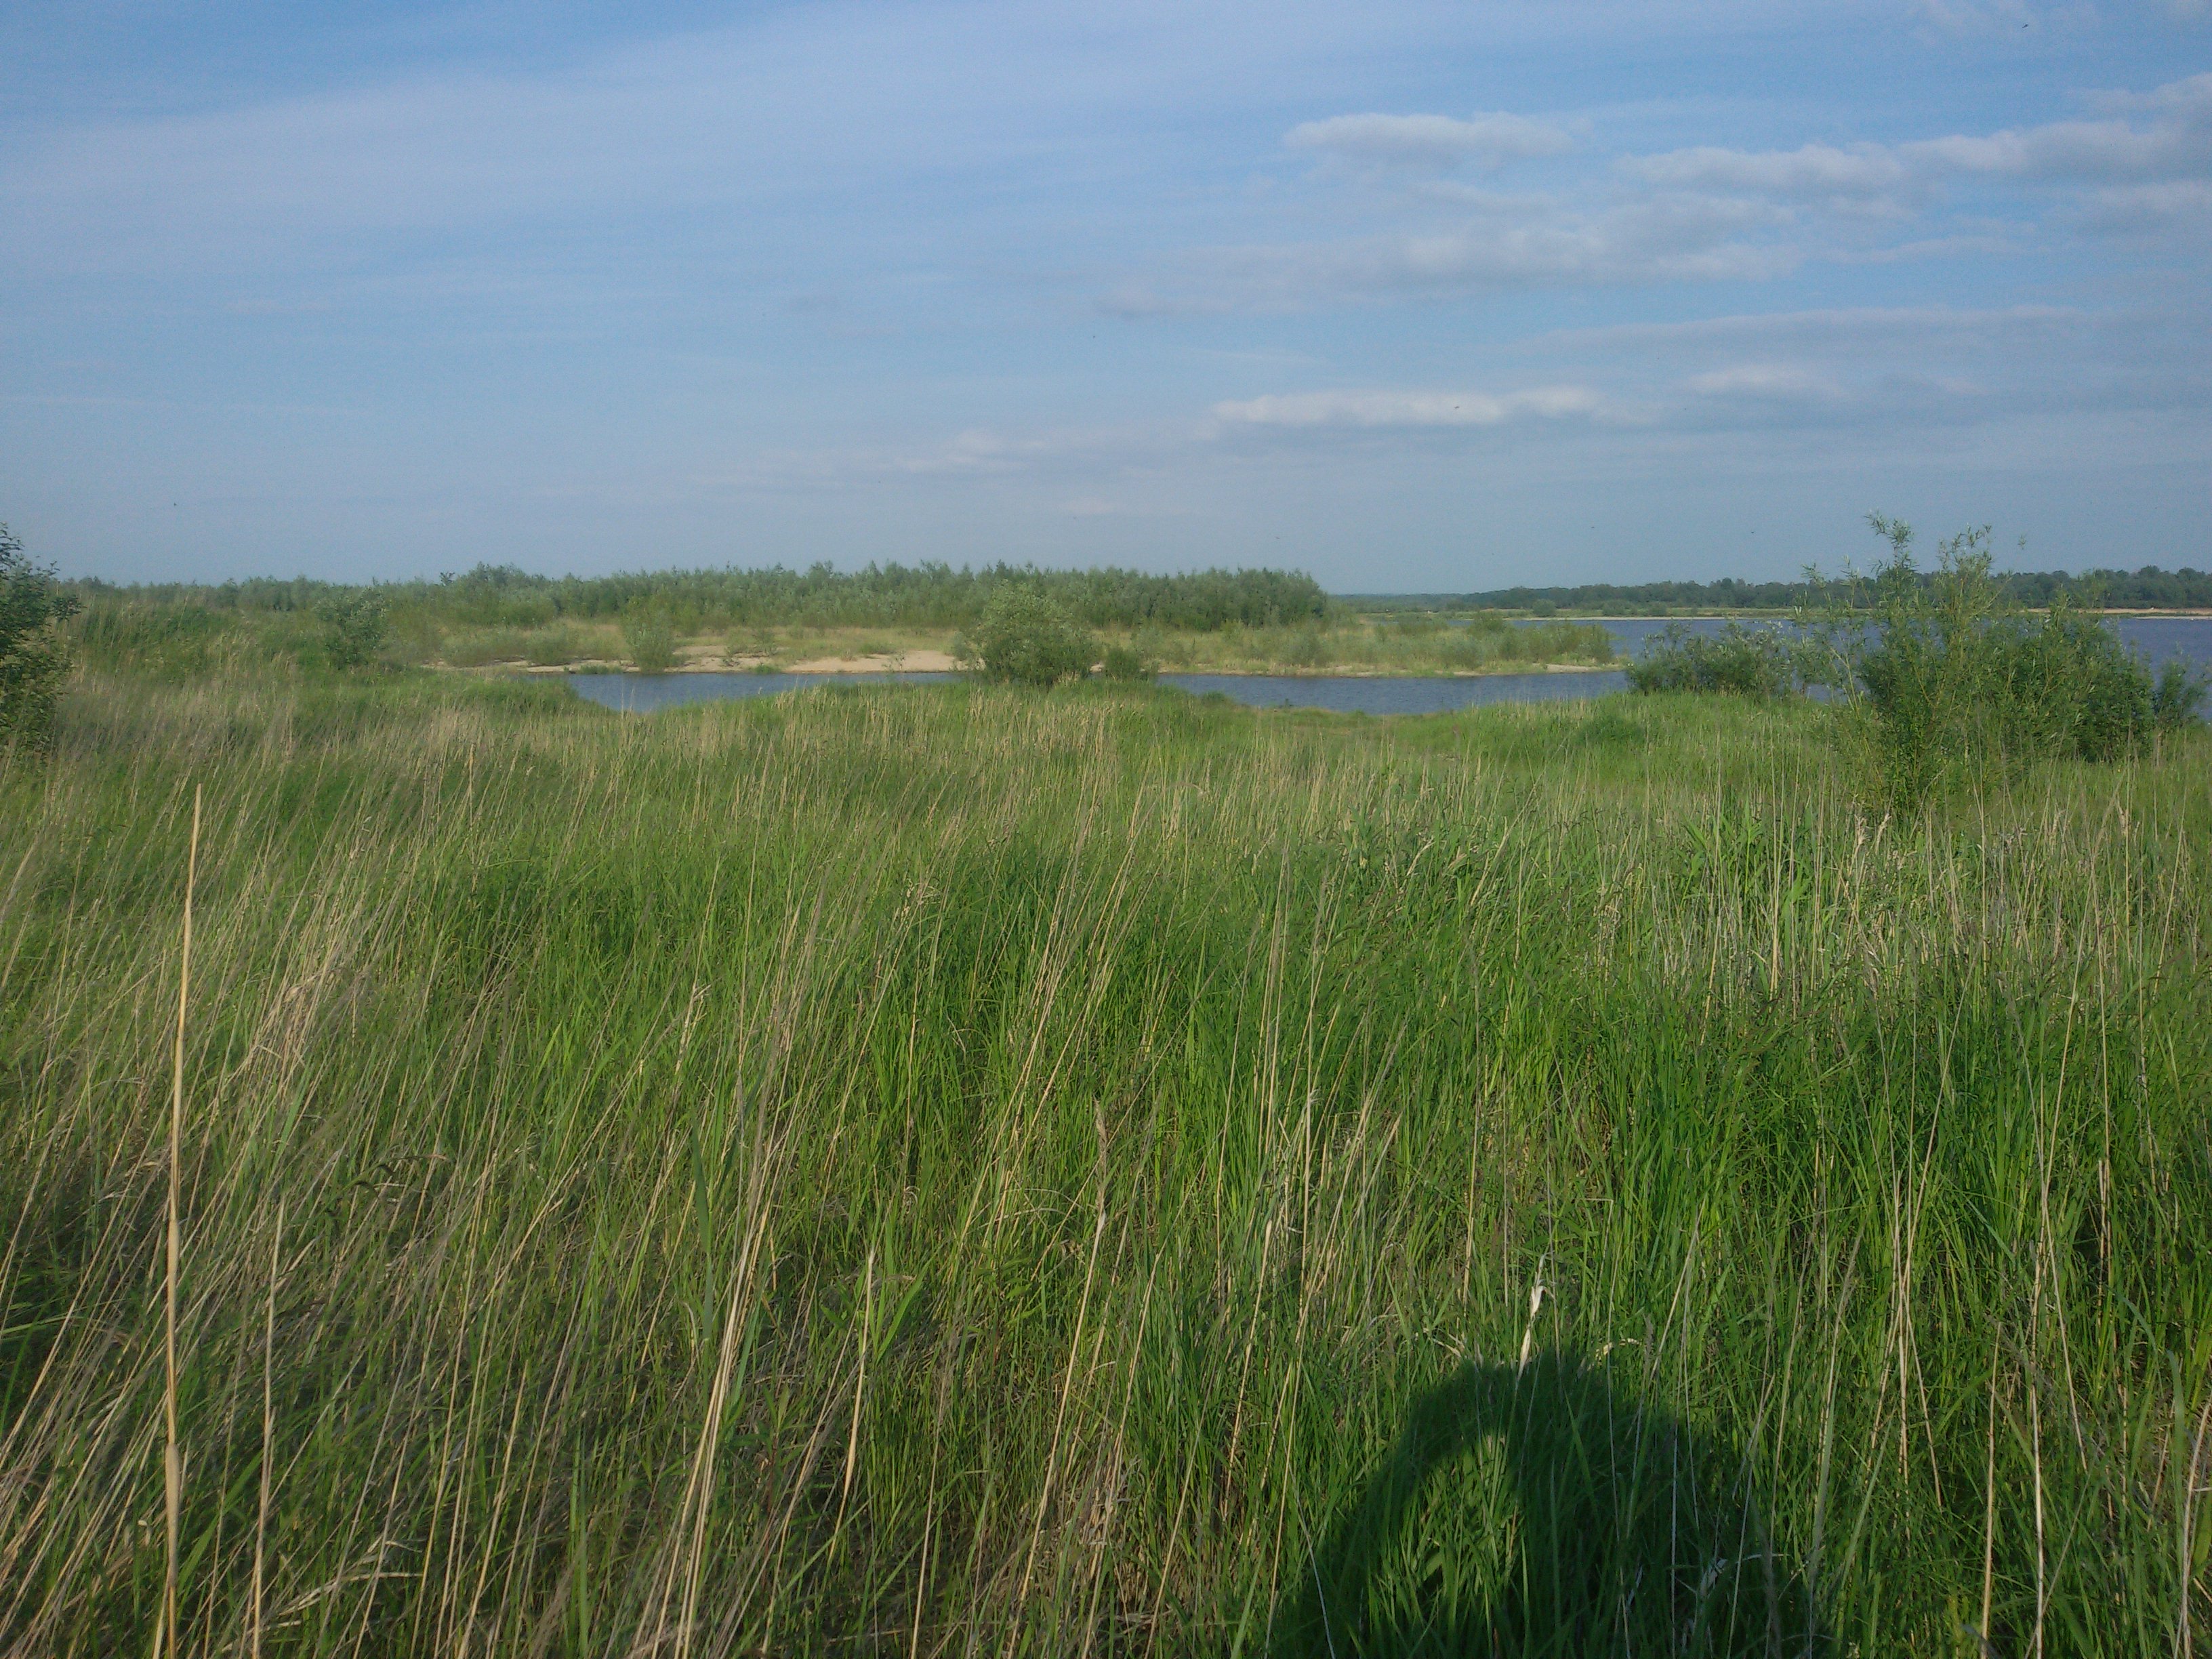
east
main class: Grassland
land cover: Grassland without tree/shrub cover
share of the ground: > 75 %
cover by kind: herbaceous plants 85 %
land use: Semi-natural and natural areas not in use
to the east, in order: Grassland without tree/shrub cover; Shrubland without tree cover; Inland fresh water bodies; Shrubland without tree cover
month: May
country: PL
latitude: 50.4418
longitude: 17.2347
